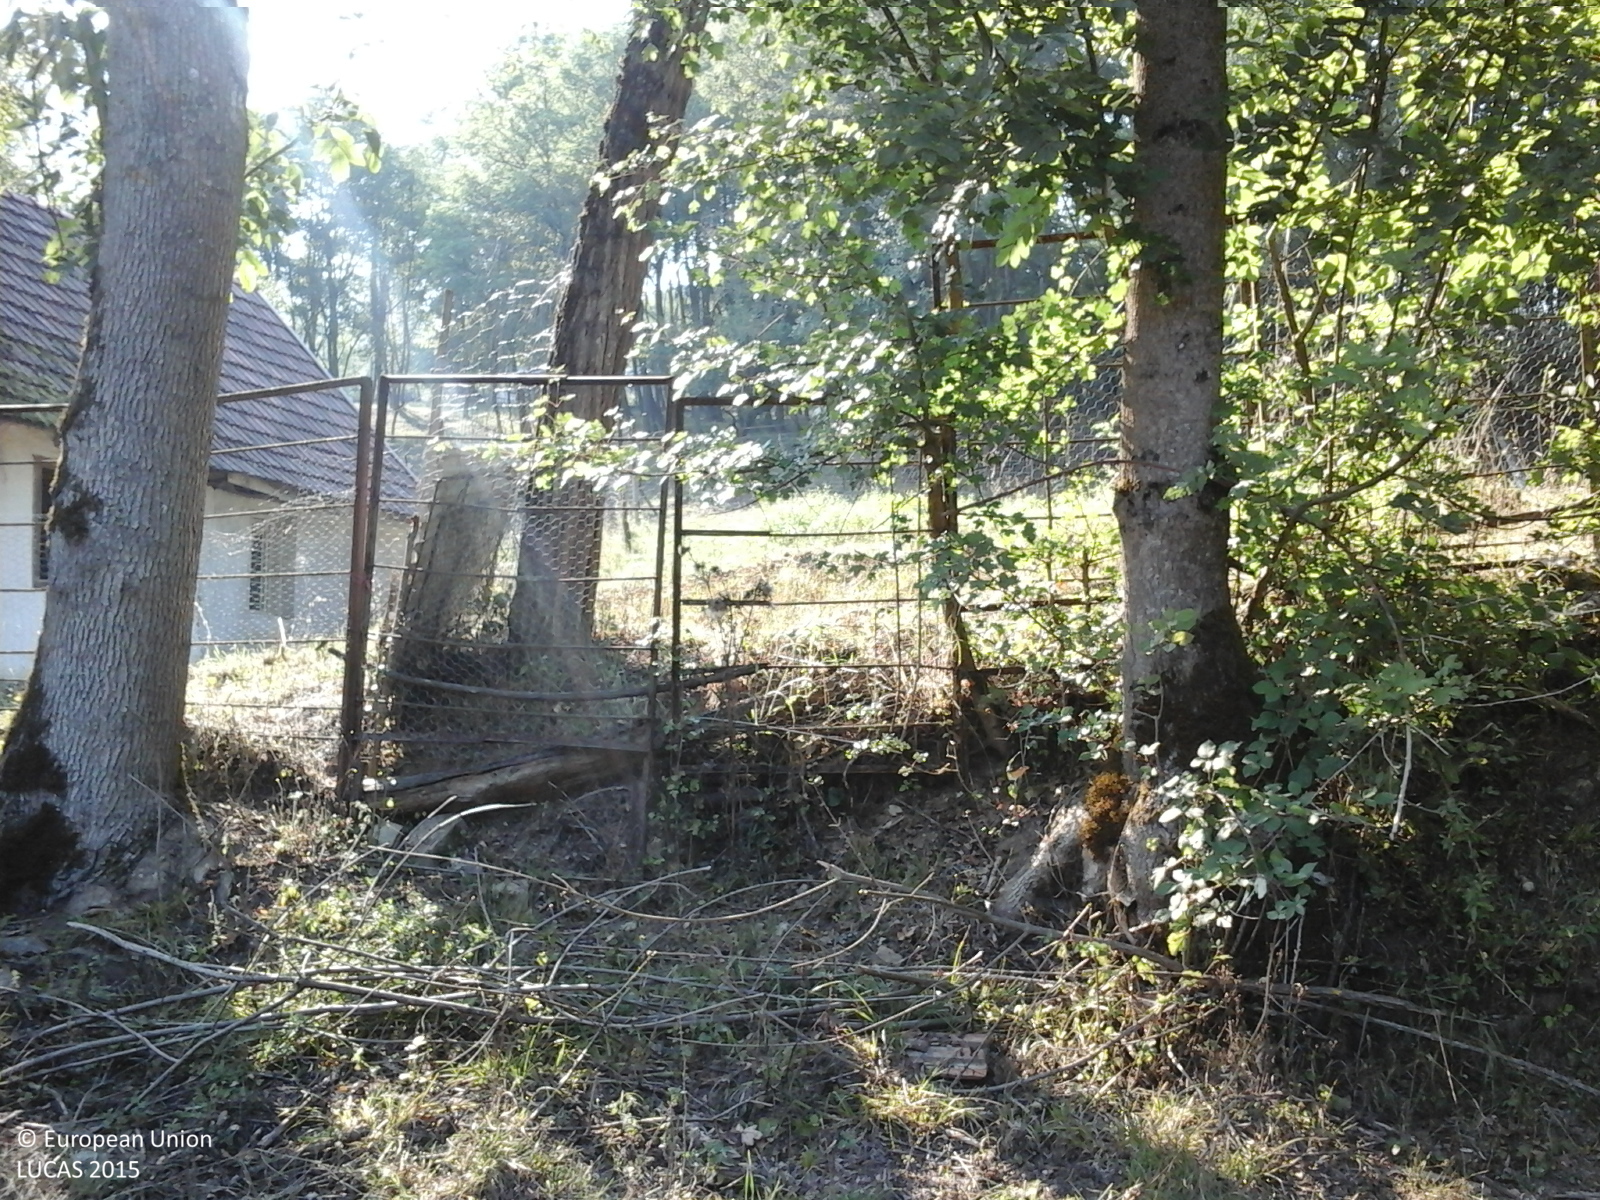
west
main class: Cropland
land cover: Lucerne
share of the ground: > 75 %
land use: Agriculture (excluding fallow land and kitchen gardens)
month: August
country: RO
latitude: 46.0999
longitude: 22.0864
